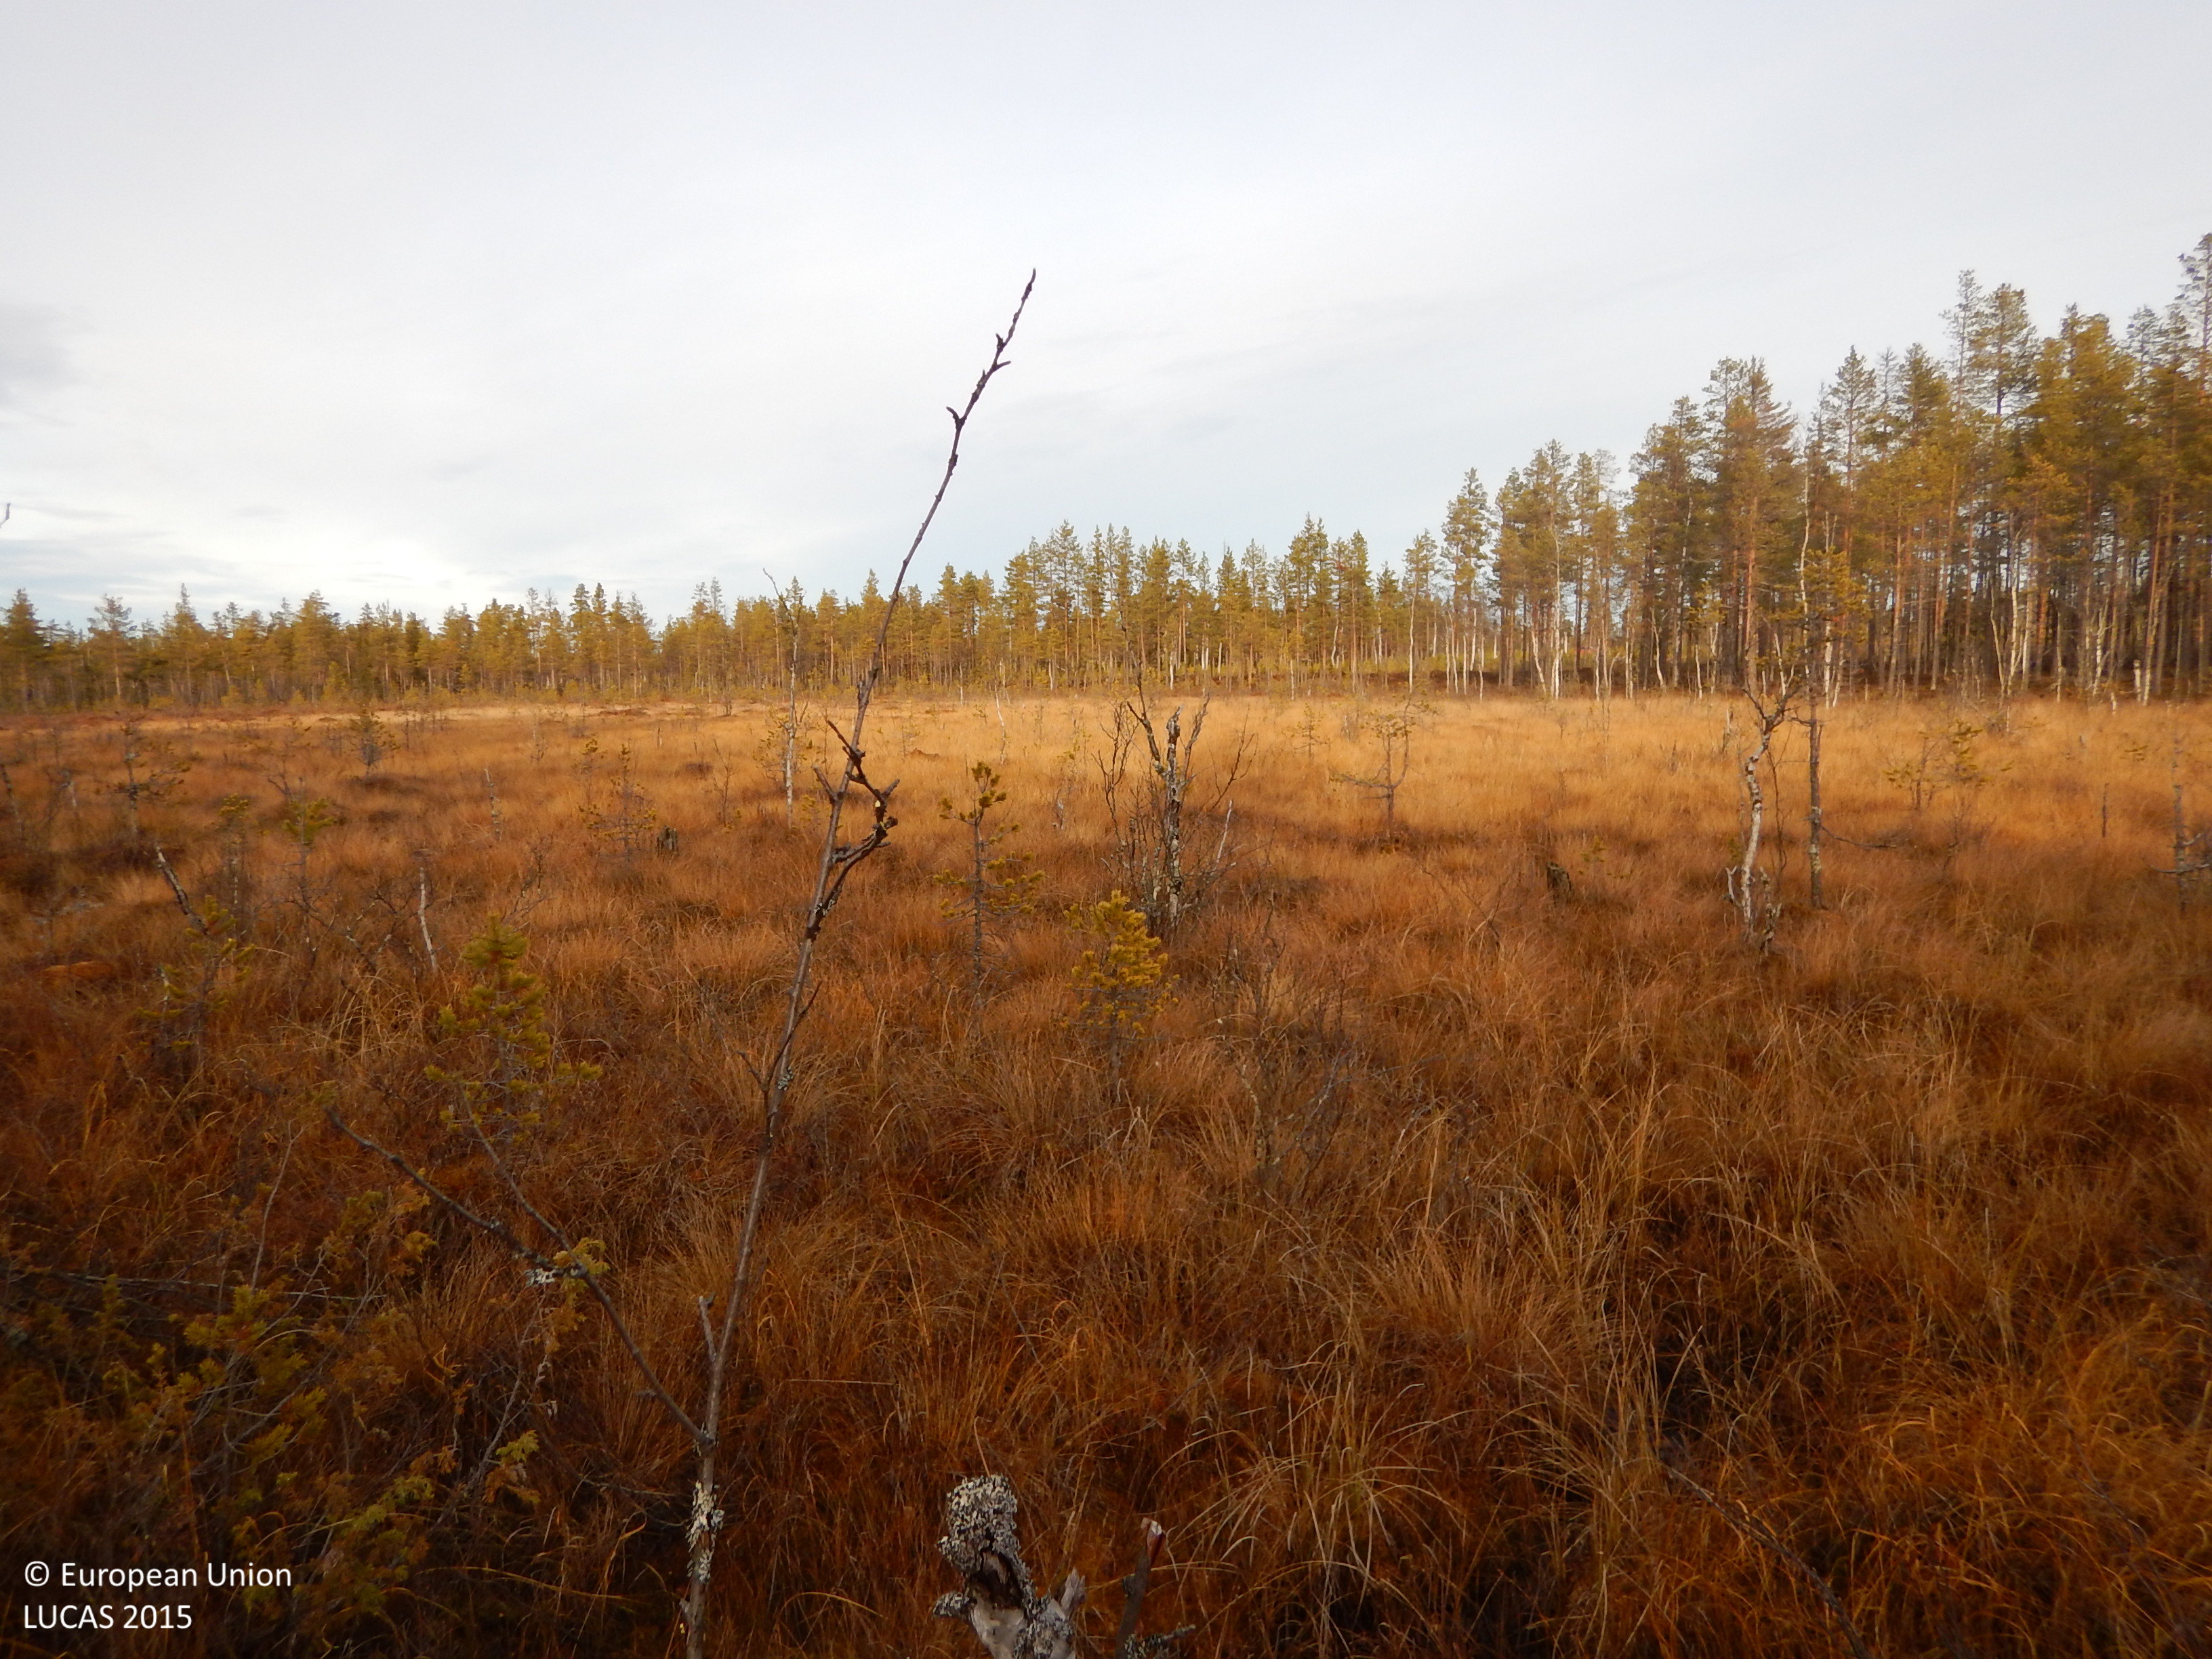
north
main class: Woodland
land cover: Pine dominated mixed woodland
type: mire and swamp forests
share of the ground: 10 - 25 %
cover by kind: herbaceous plants 60 %, coniferous forest trees 10 %, broadleaved forest trees 10 %, shrubs 10 %, lichens and mosses 10 %
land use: Semi-natural and natural areas not in use
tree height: > 5 m
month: October
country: SE
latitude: 65.3248
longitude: 20.2504
